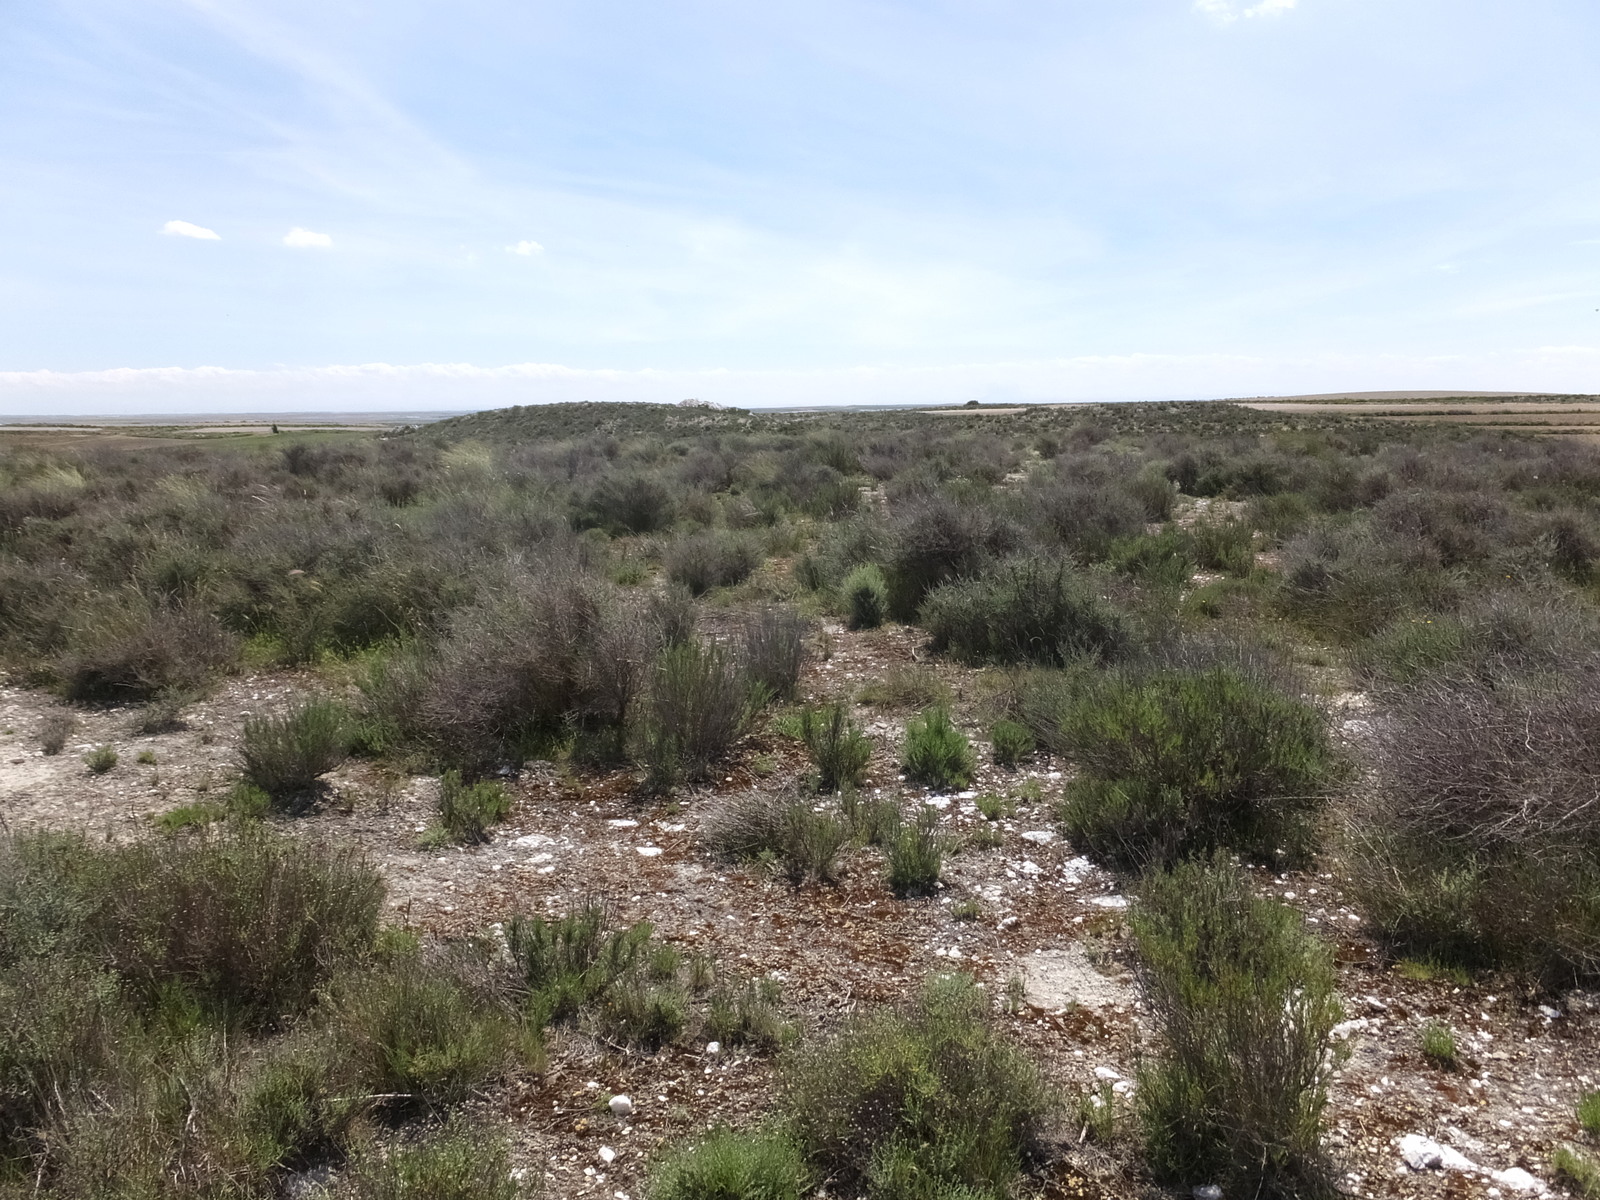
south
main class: Shrubland
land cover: Shrubland without tree cover
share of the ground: > 75 %
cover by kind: shrubs 100 %
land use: Semi-natural and natural areas not in use
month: April
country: ES
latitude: 41.5202
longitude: -0.1896
